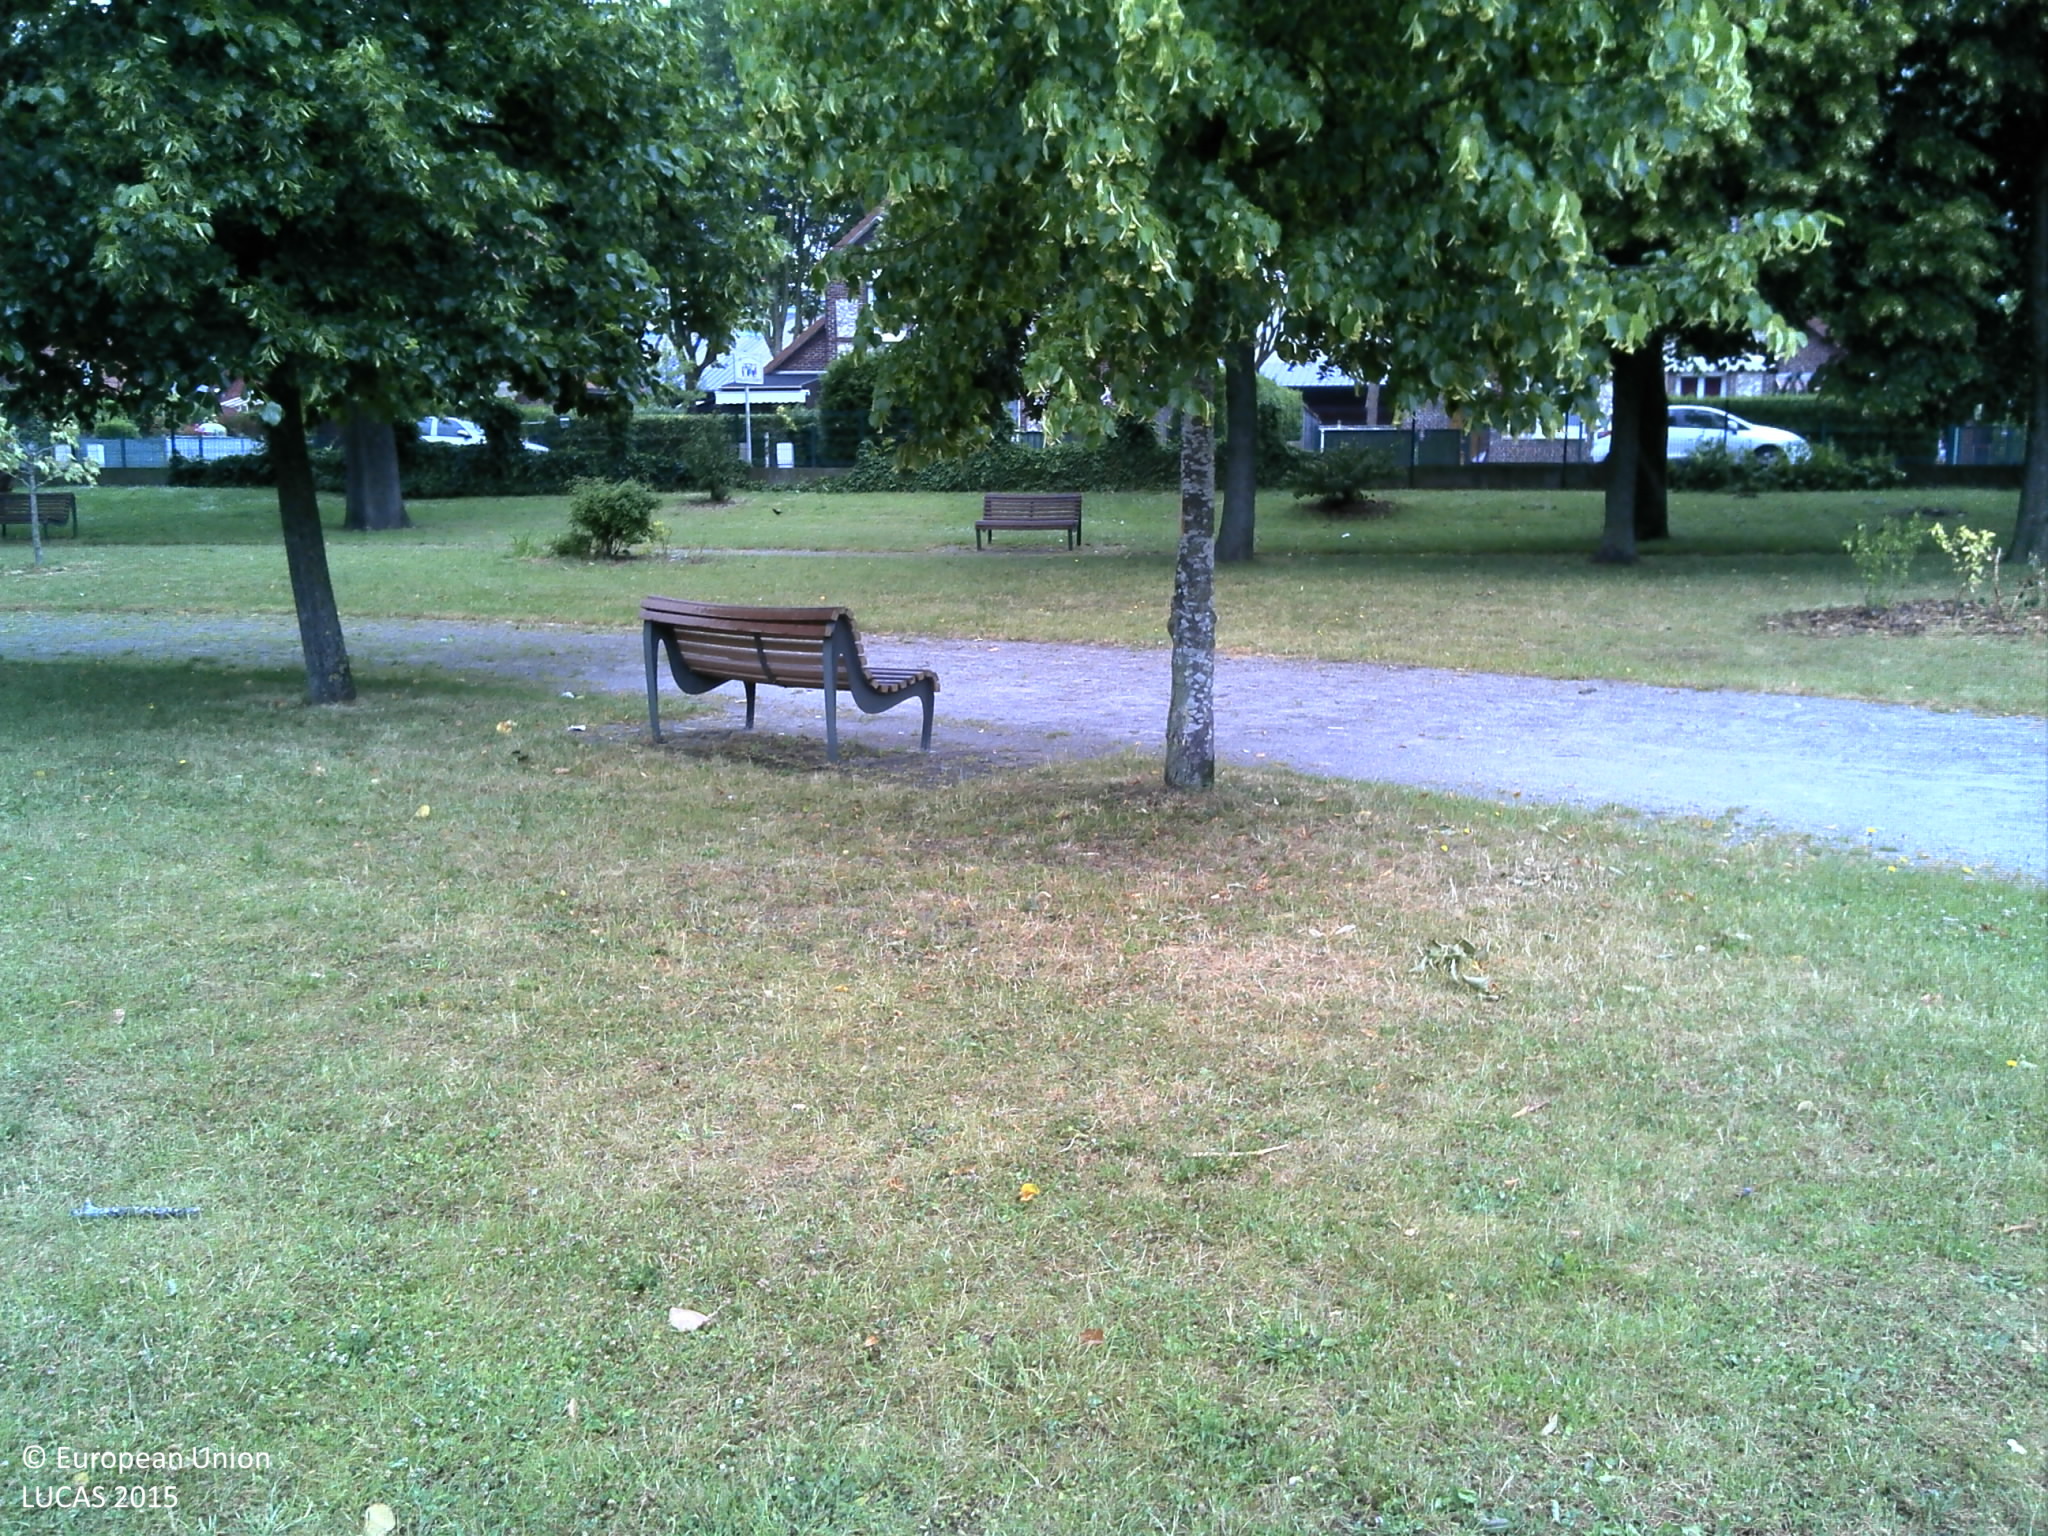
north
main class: Grassland
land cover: Grassland with sparse tree/shrub cover
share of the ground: > 75 %
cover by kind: herbaceous plants 95 %, broadleaved forest trees 5 %
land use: Amenities, museums, leisure
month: June
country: FR
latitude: 49.4141
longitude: 1.0324
